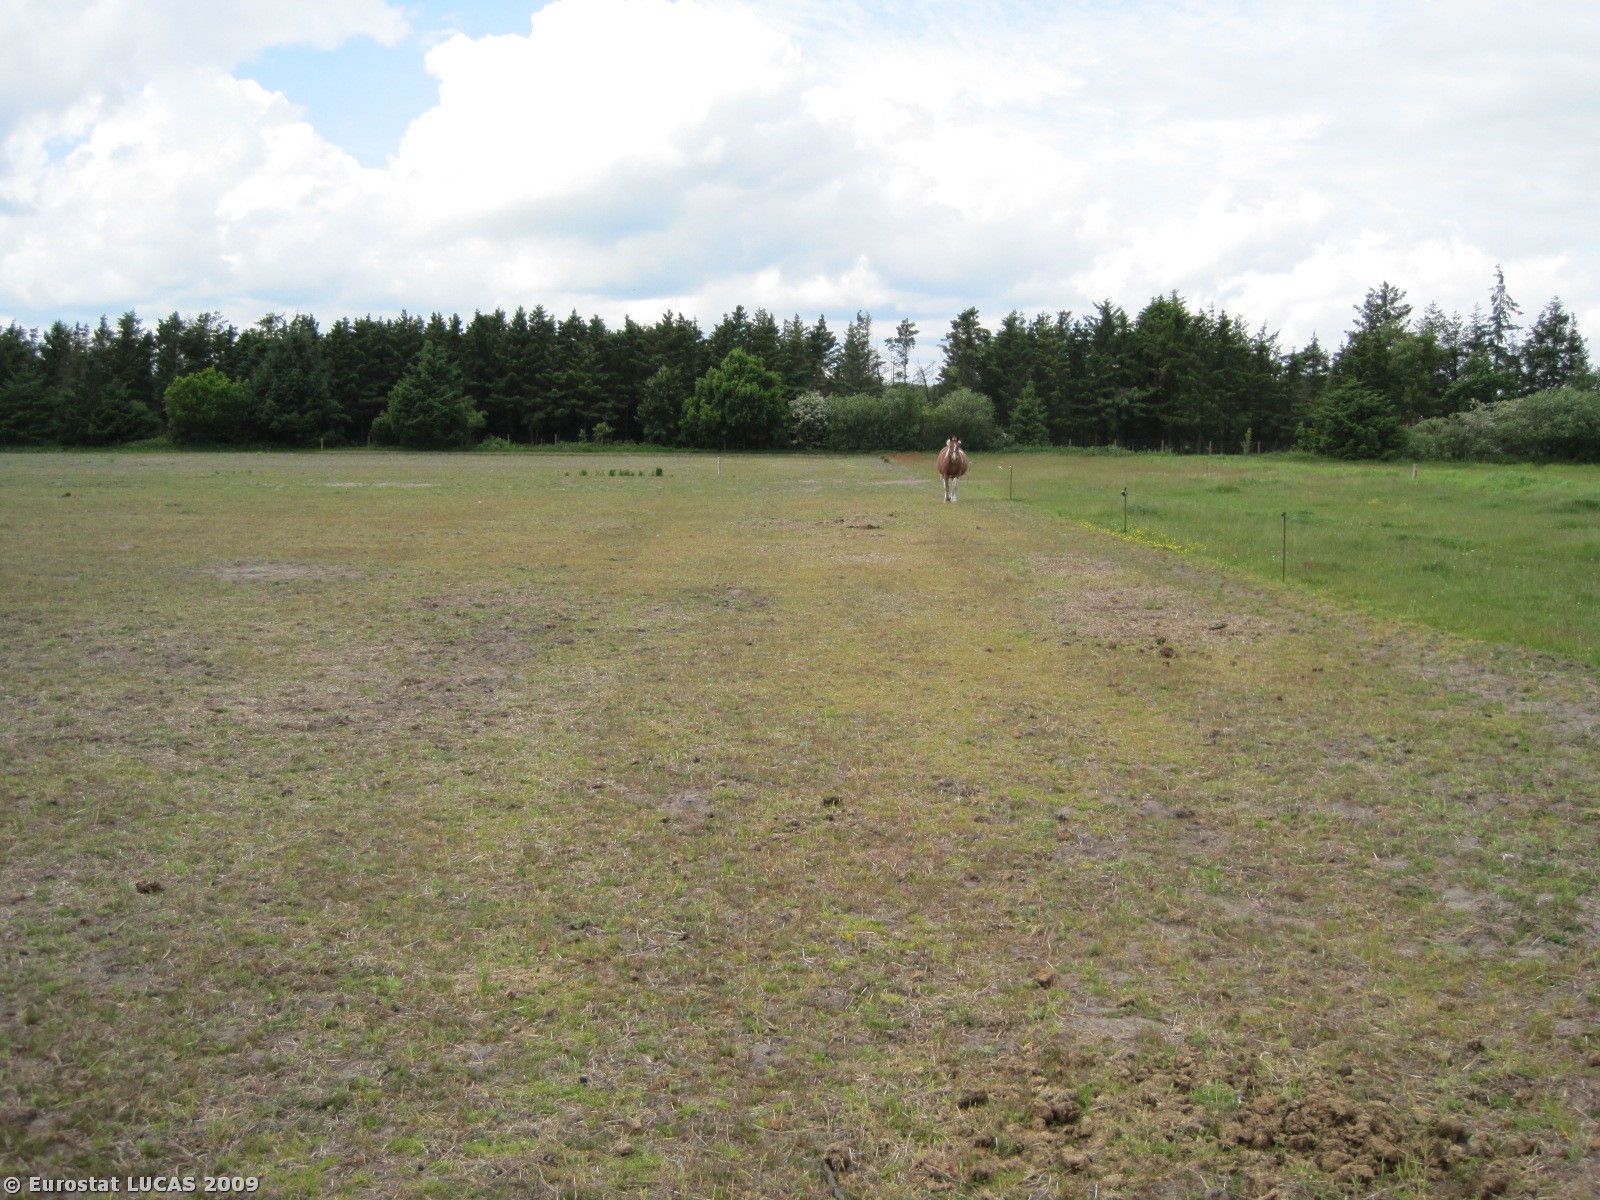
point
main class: Grassland
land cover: Grassland without tree/shrub cover
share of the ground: > 75 %
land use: Agriculture (excluding fallow land and kitchen gardens)
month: June
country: DK
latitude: 56.9964
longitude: 10.2794
